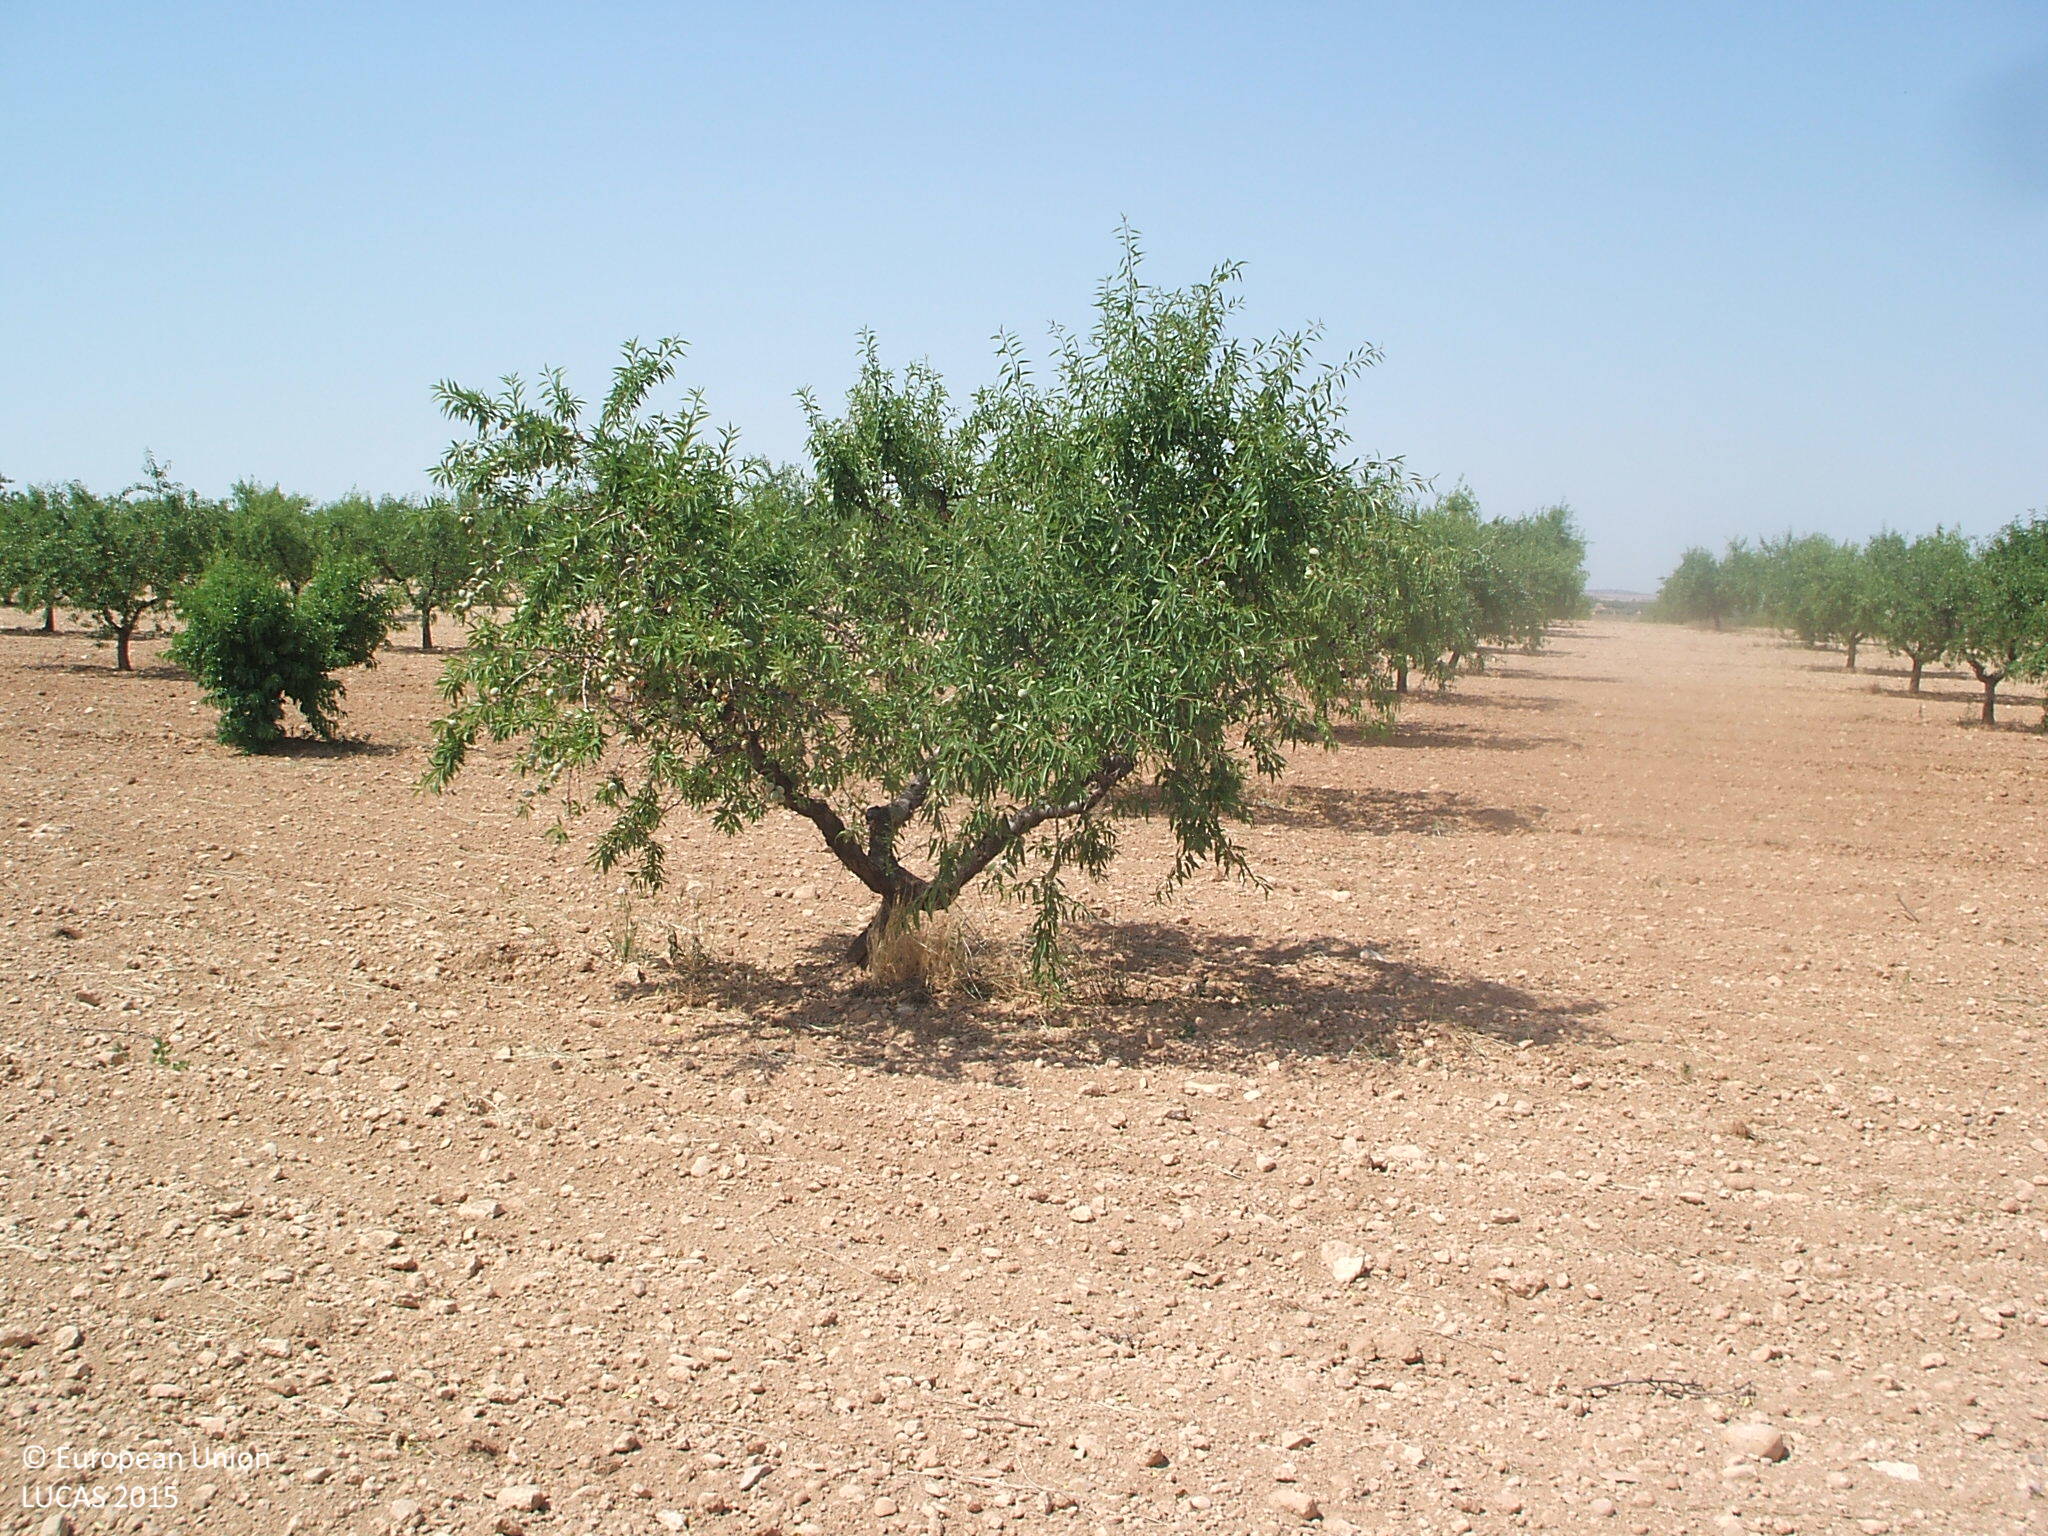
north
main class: Cropland
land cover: Nuts trees
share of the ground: 25 - 50 %
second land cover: Other bare soil
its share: > 75 %
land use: Agriculture (excluding fallow land and kitchen gardens)
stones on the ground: > 50 %
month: June
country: ES
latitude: 40.9508
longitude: -0.2395
